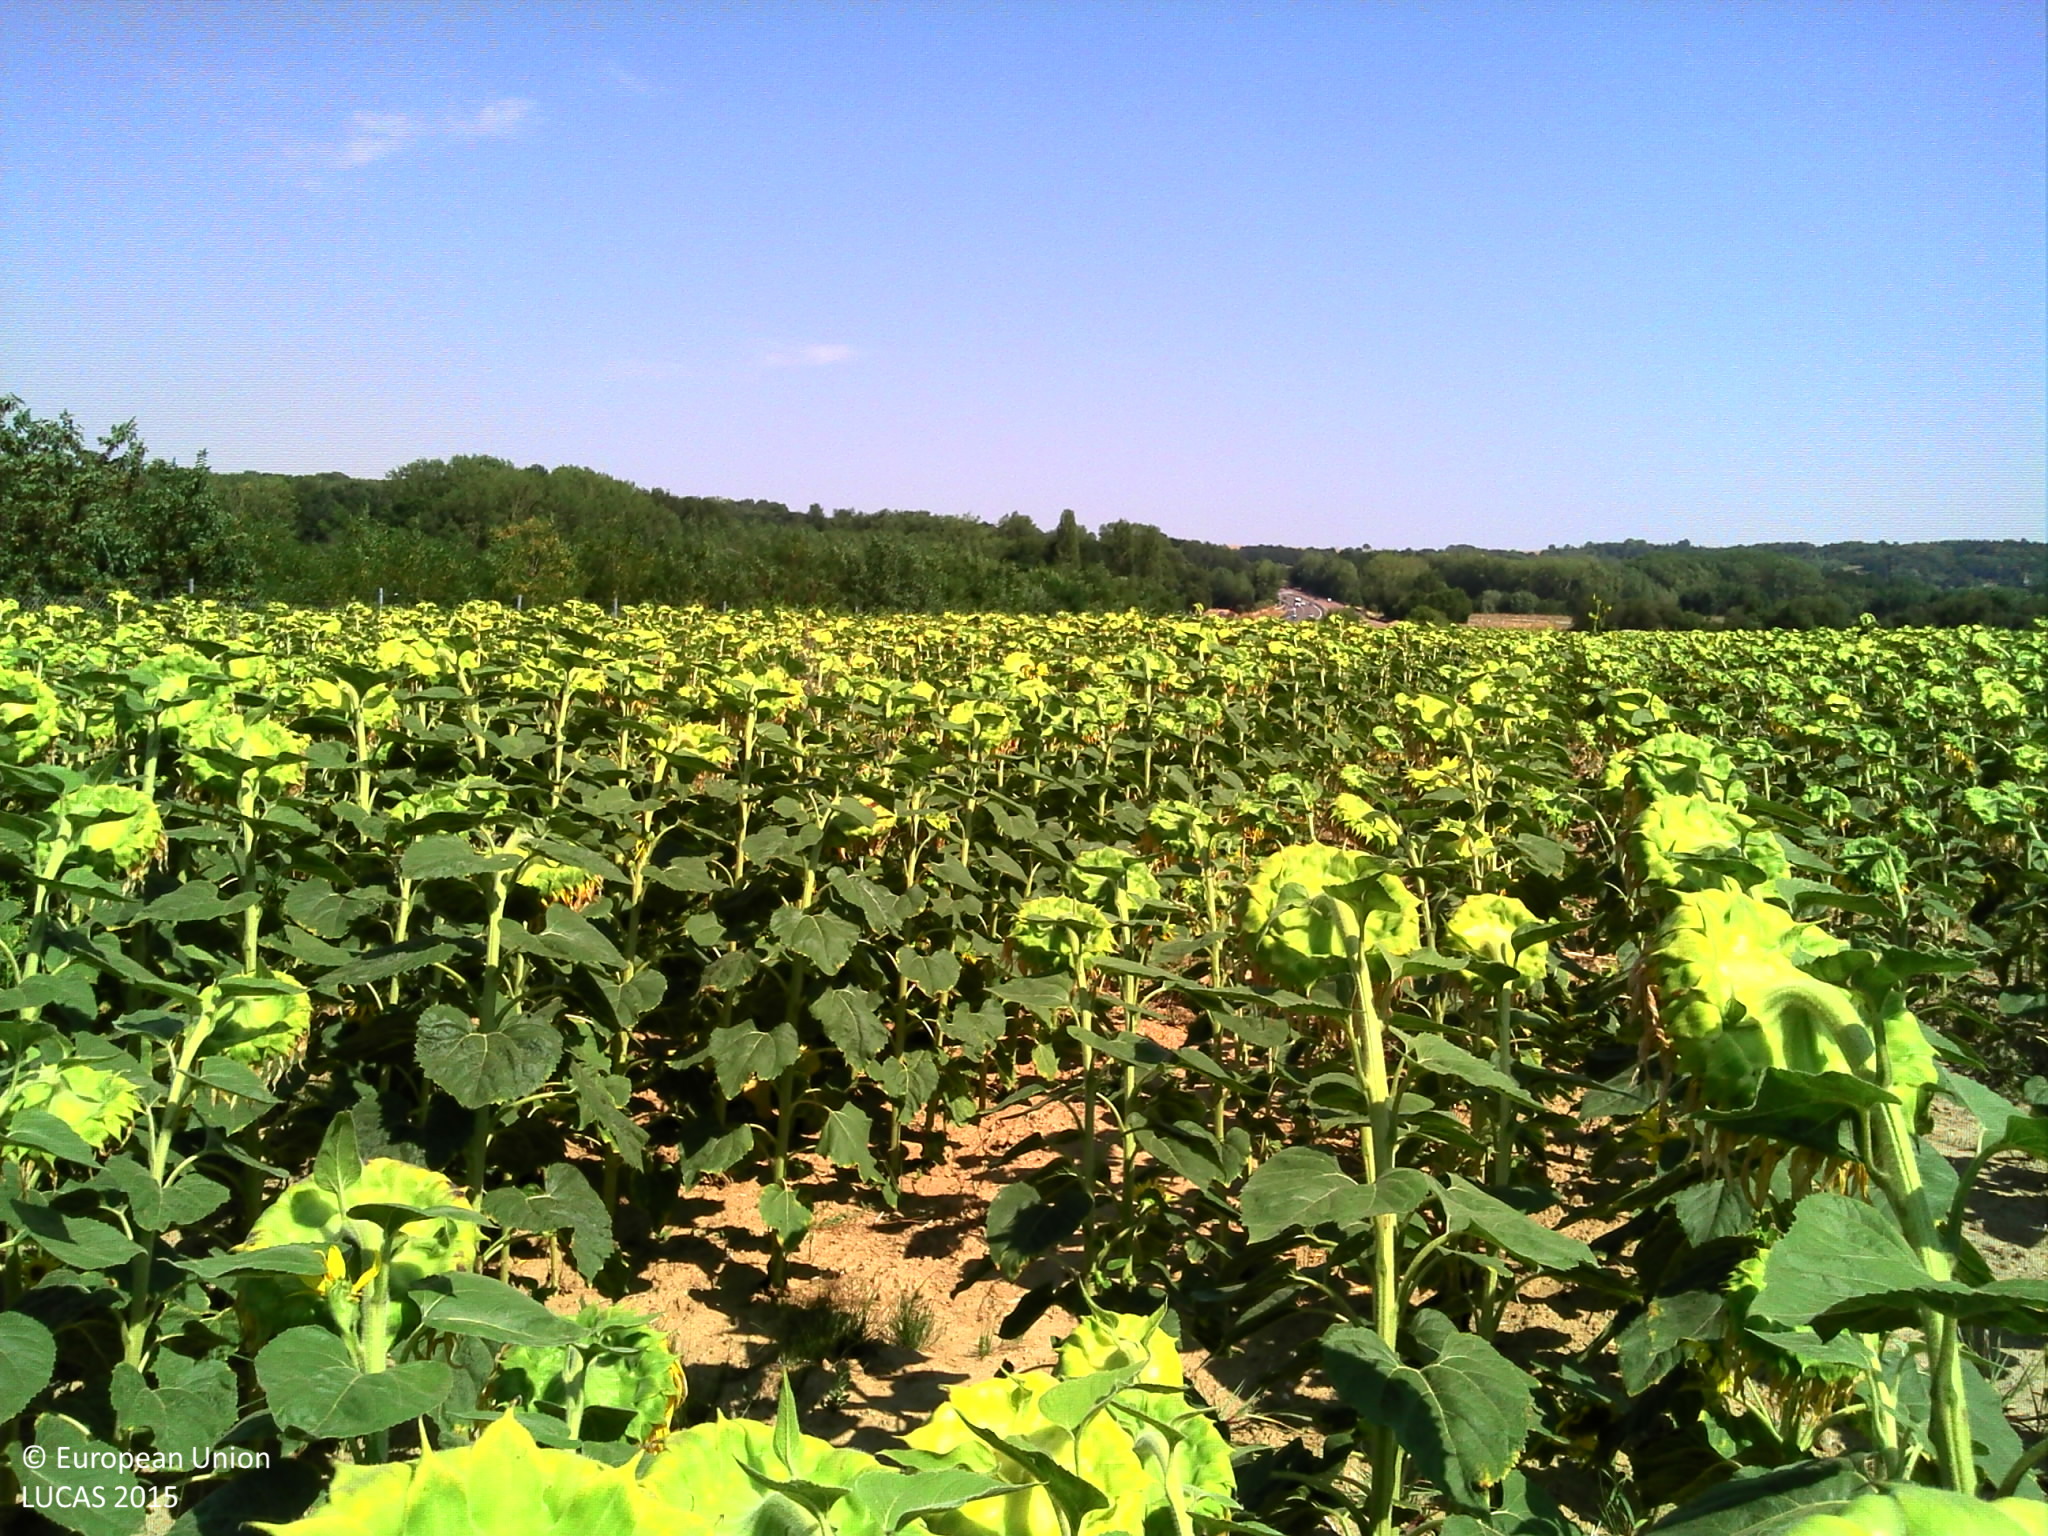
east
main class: Cropland
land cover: Sunflower
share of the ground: > 75 %
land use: Agriculture (excluding fallow land and kitchen gardens)
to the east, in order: Sunflower; Grass margins; Fences; Grassland without tree/shrub cover; Lines of trees; Grassland without tree/shrub cover; Paved roads, cycling and walking lanes; Grassland with sparse tree/shrub cover; Fences; Electric lines; Grassland without tree/shrub cover
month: August
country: FR
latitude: 47.8830
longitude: 3.4291
